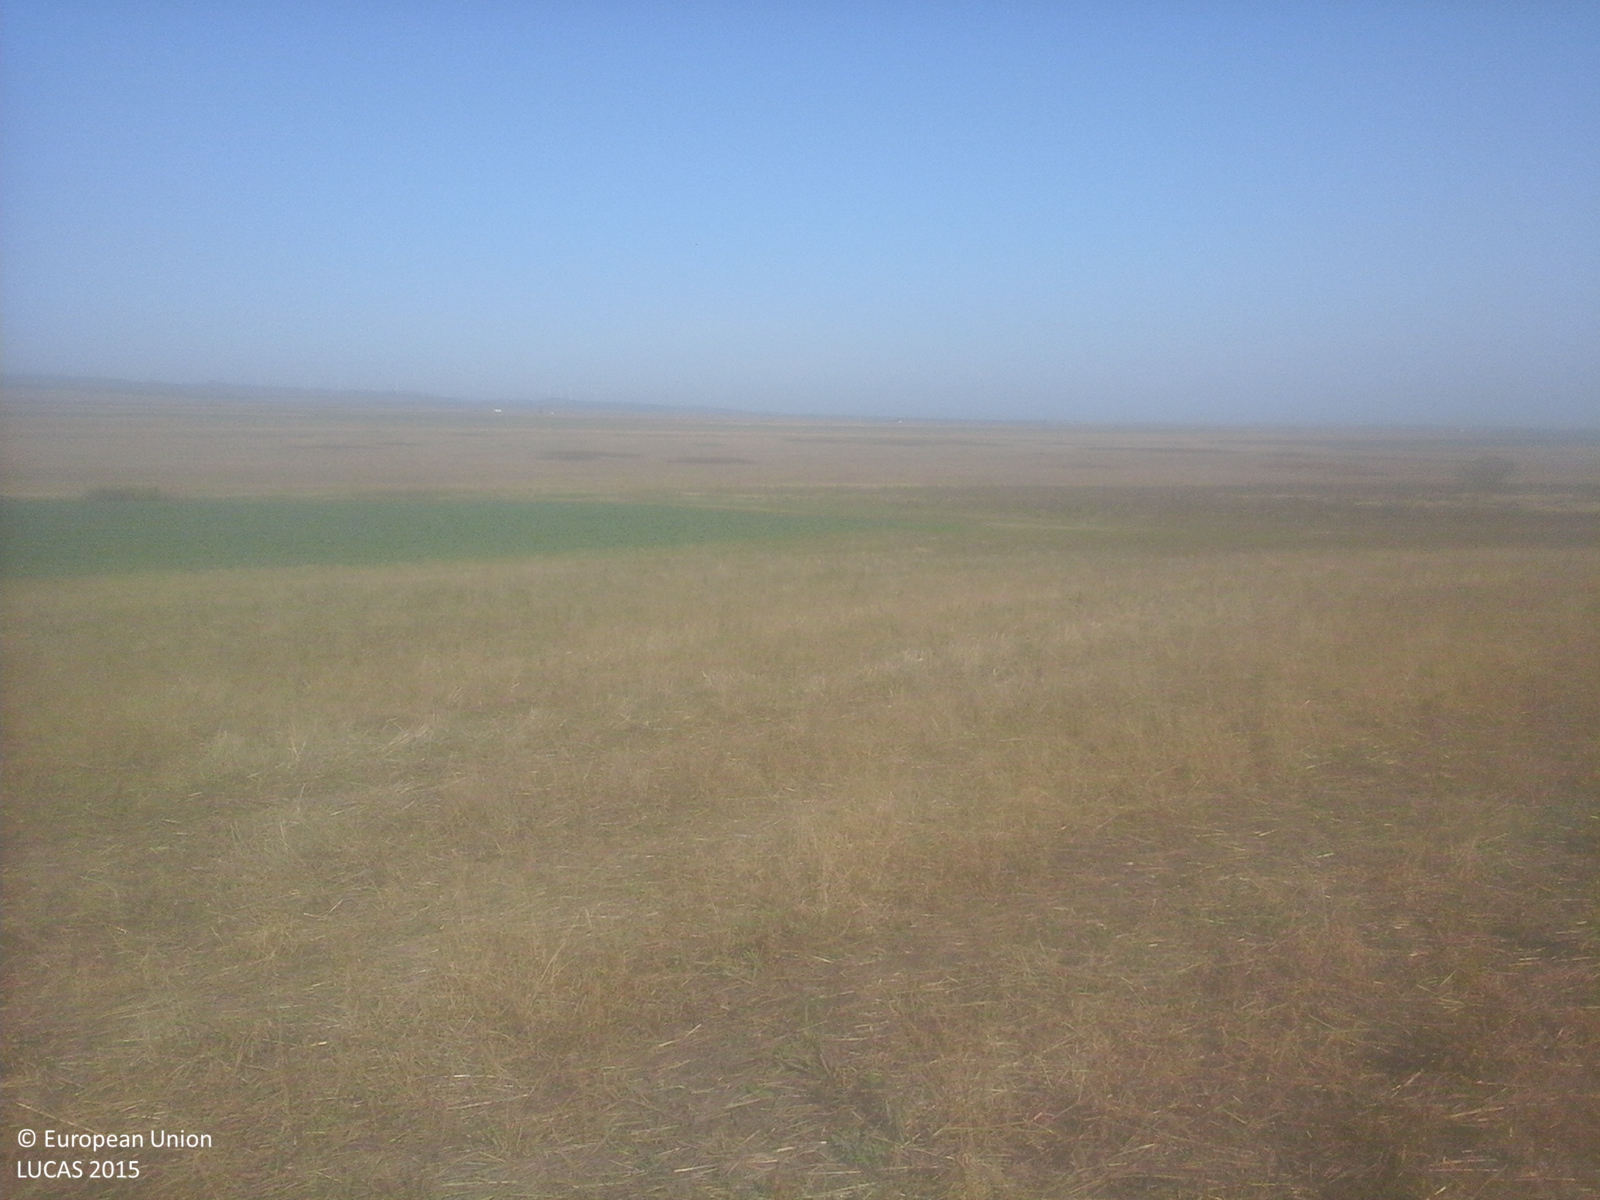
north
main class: Cropland
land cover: Common wheat
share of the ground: > 75 %
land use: Agriculture (excluding fallow land and kitchen gardens)
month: October
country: RO
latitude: 45.3149
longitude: 26.9613
